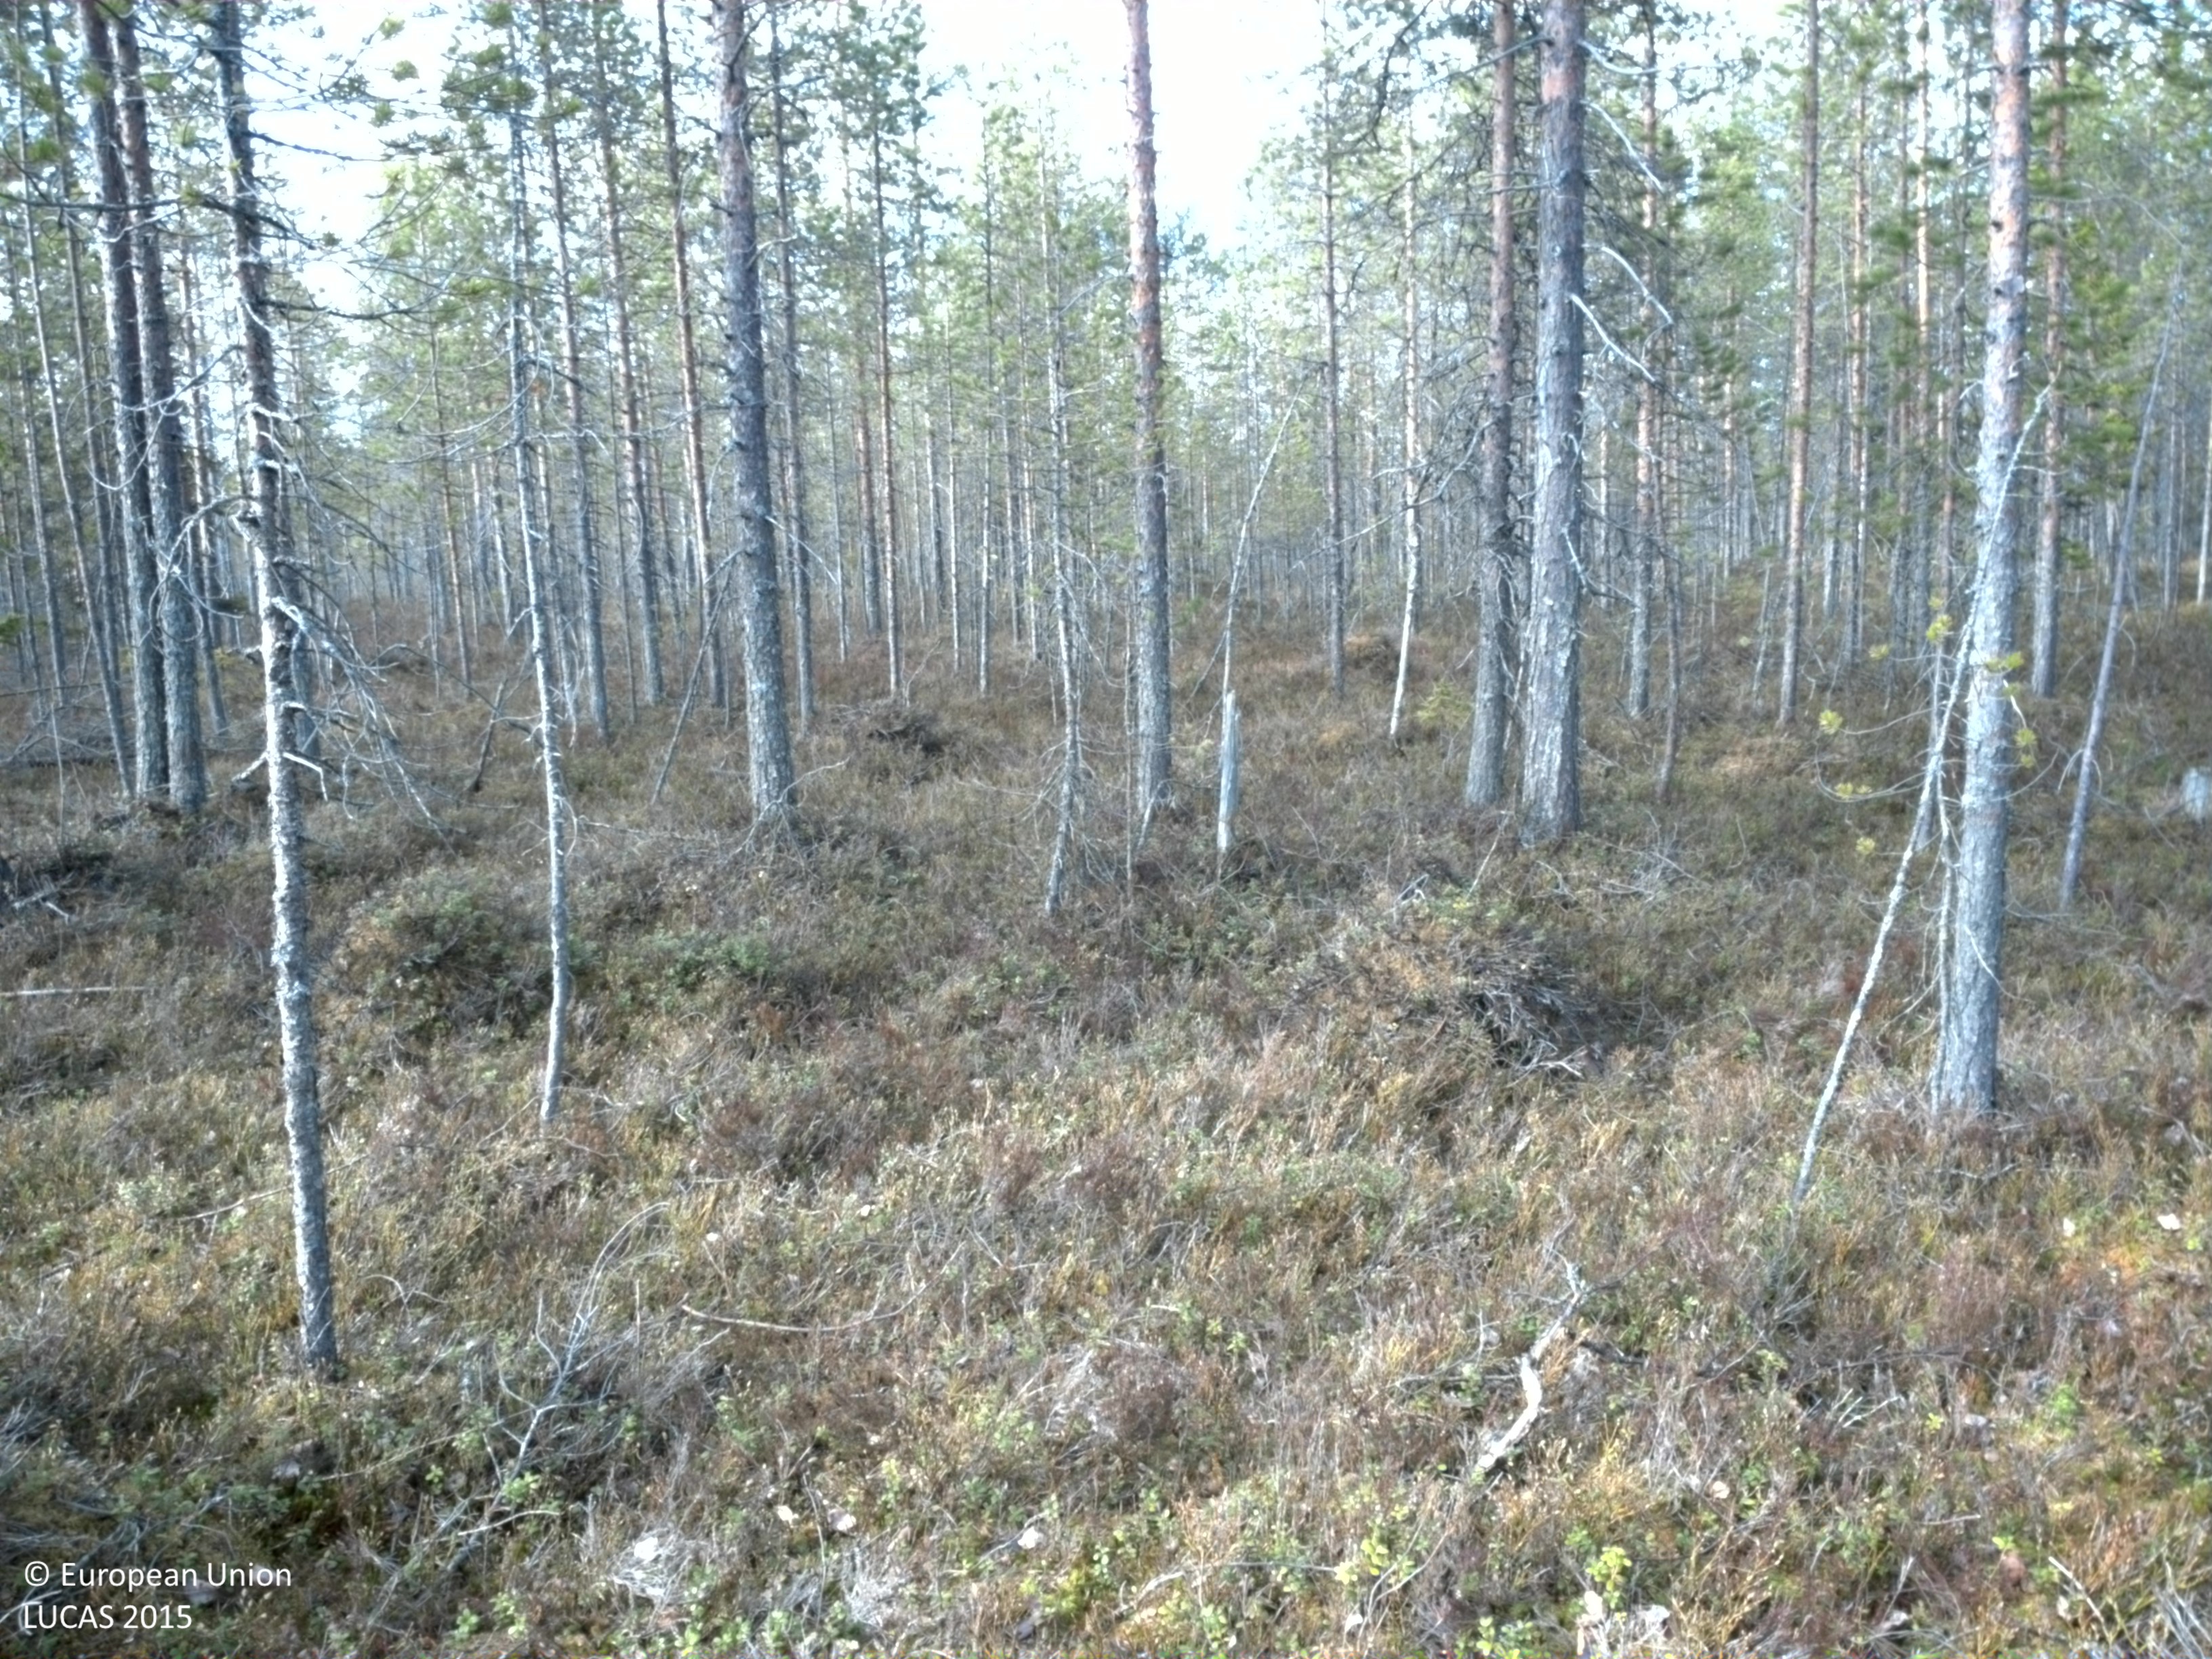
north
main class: Woodland
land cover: Pine dominated coniferous woodland
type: boreal forest
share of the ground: > 75 %
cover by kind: coniferous forest trees 80 %, shrubs 20 %
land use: Forestry
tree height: > 5 m
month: May
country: SE
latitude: 65.9720
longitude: 23.7061
